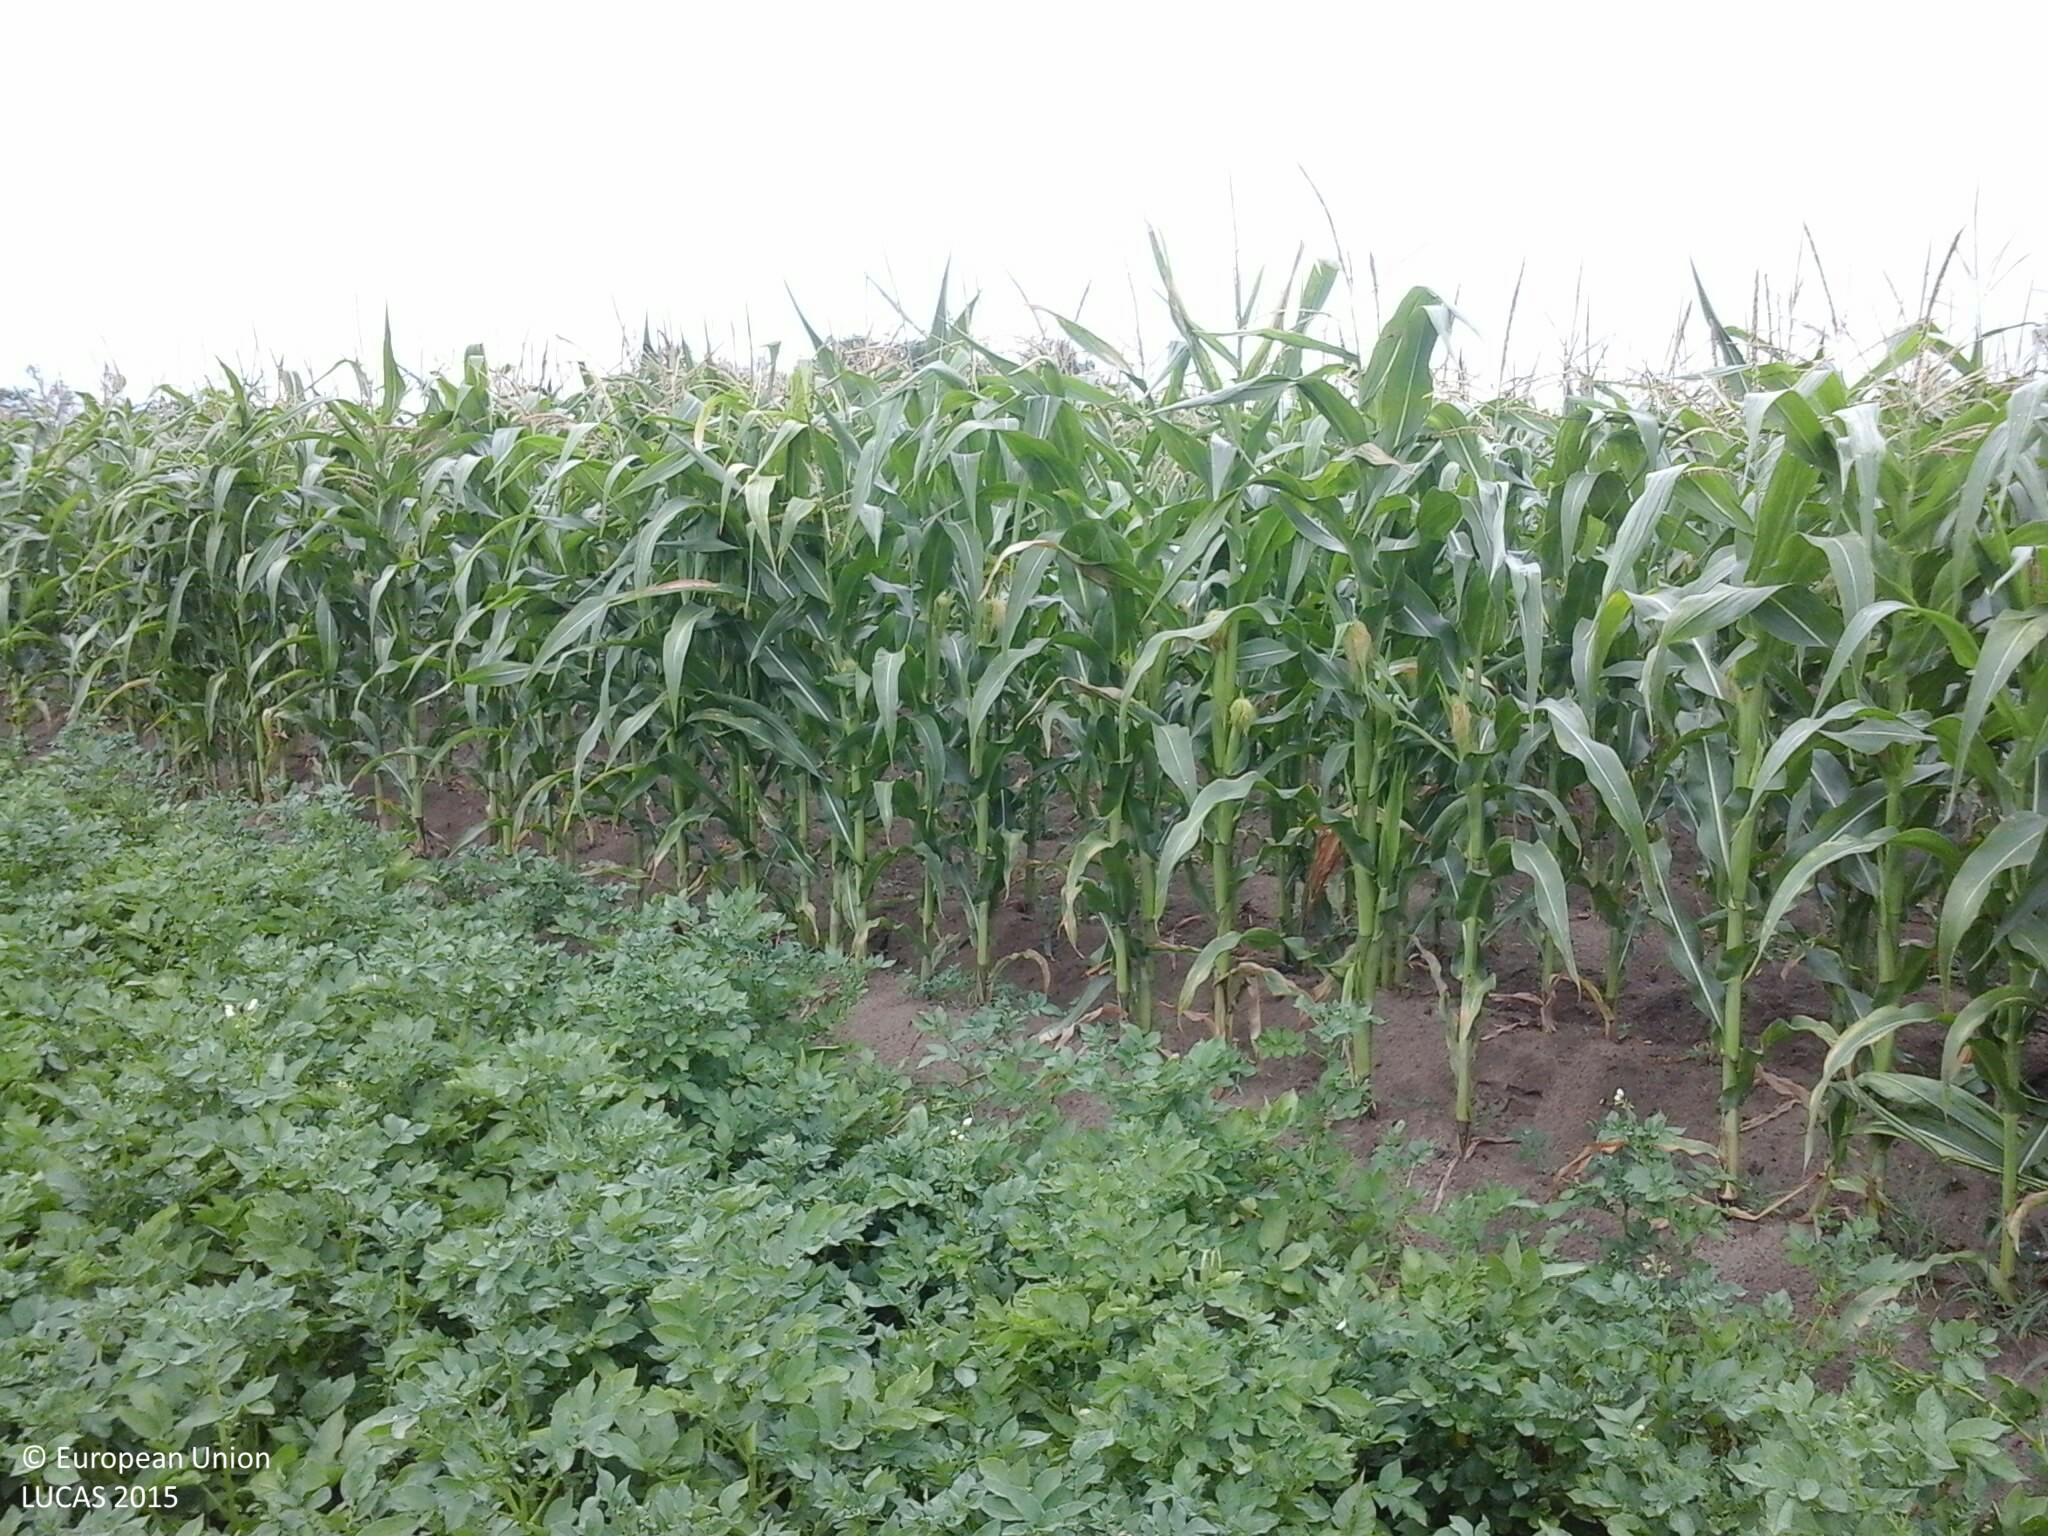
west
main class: Cropland
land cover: Potatoes
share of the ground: > 75 %
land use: Agriculture (excluding fallow land and kitchen gardens)
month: July
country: HU
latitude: 46.4766
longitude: 20.0379
